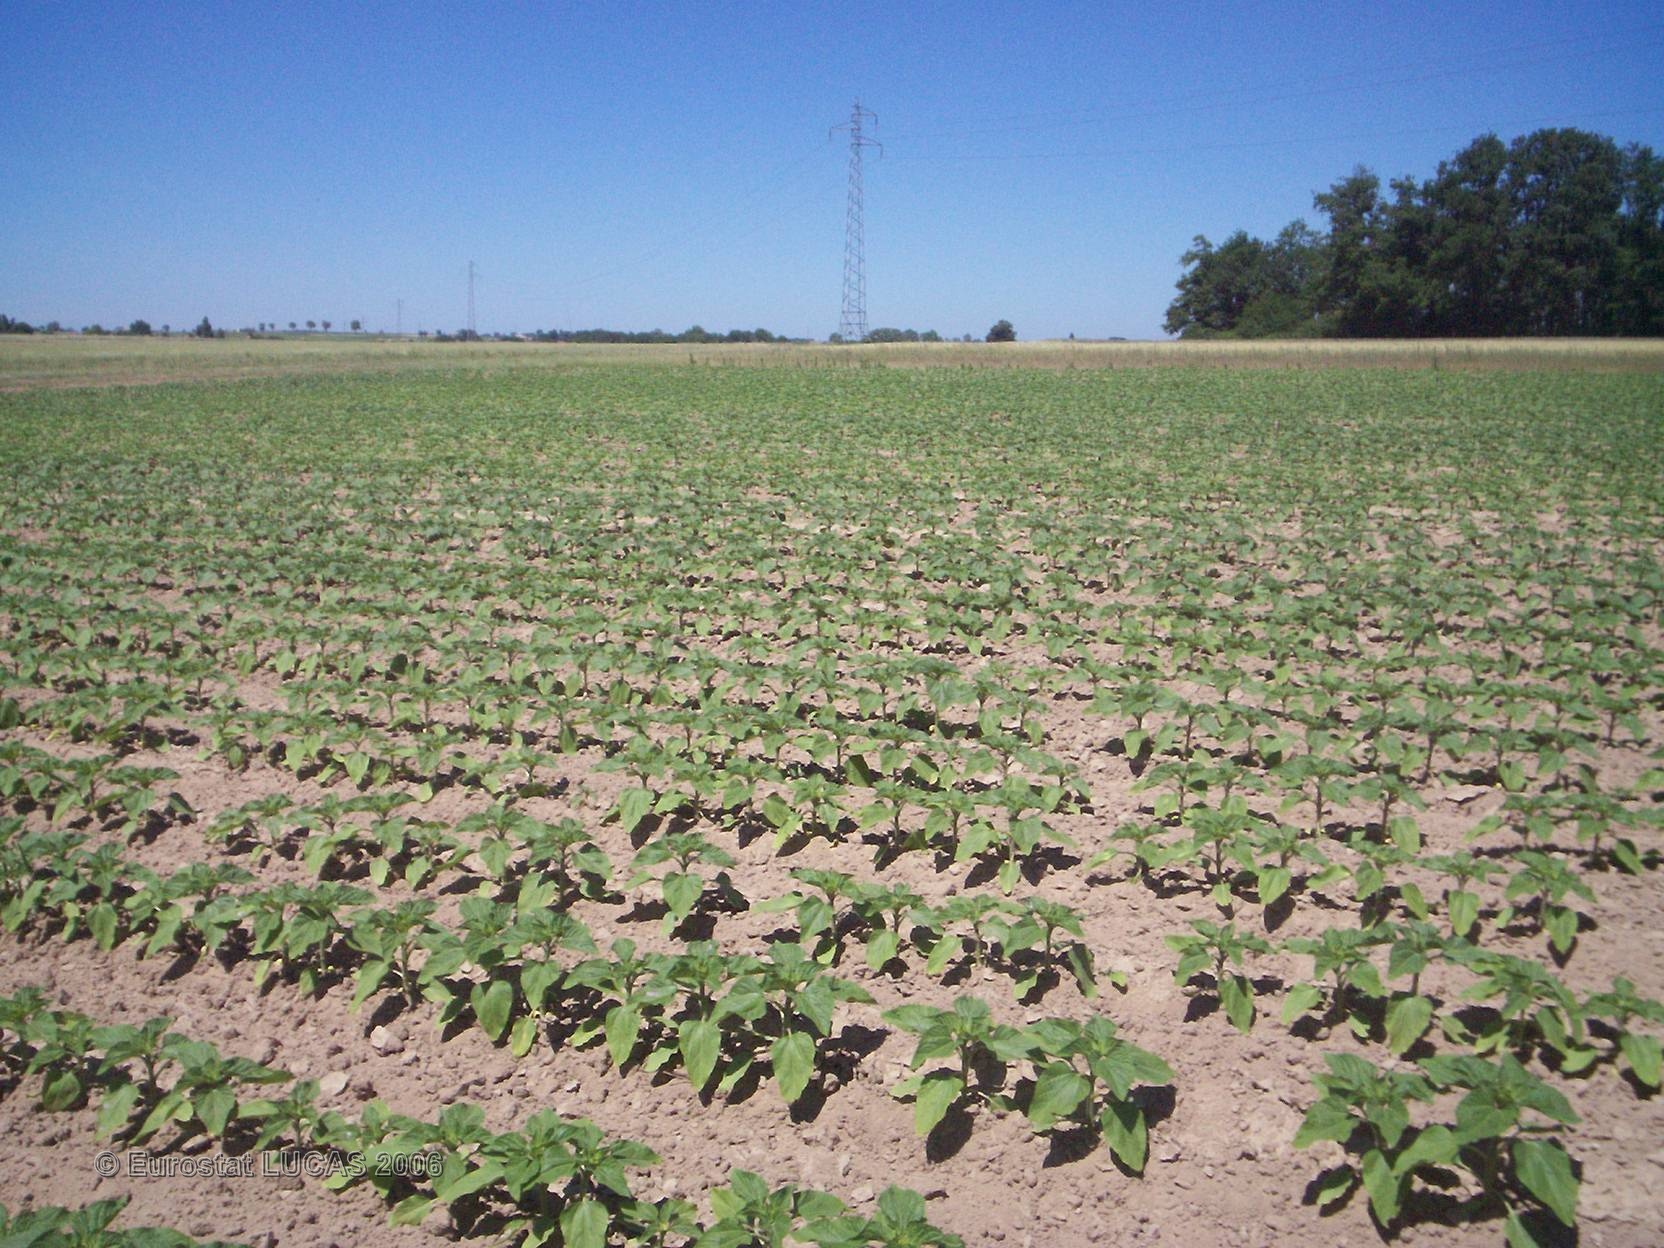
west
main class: Cropland
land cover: Sunflower
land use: Agriculture (excluding fallow land and kitchen gardens)
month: May
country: FR
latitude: 45.5005
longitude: -0.7356
